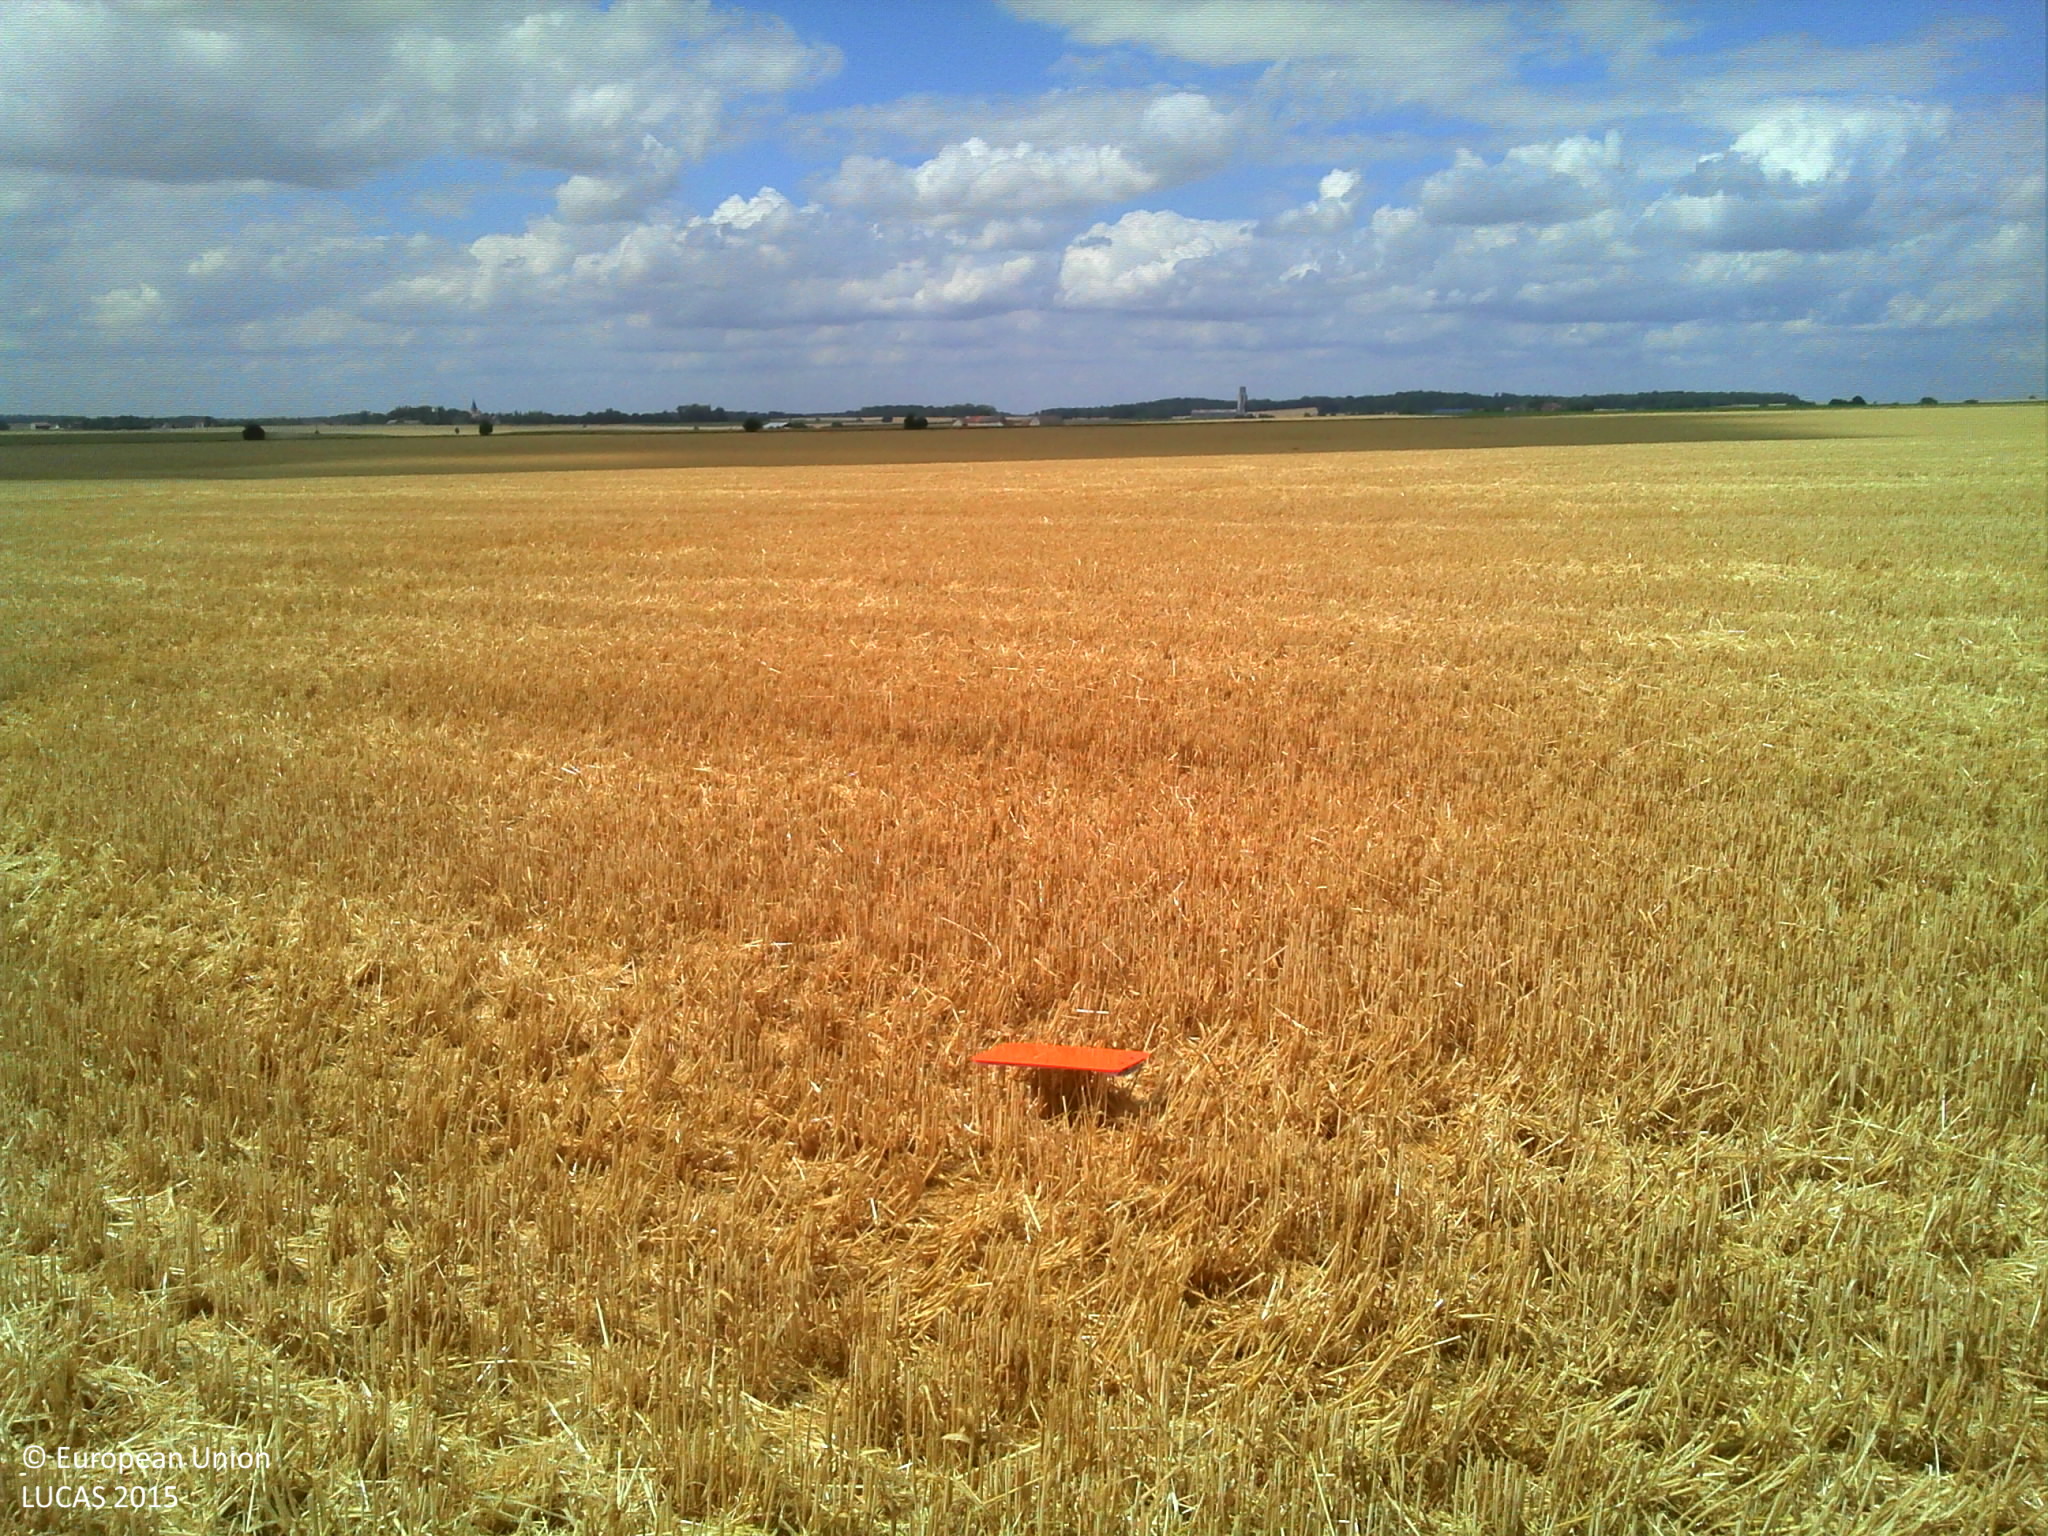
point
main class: Cropland
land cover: Barley
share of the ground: > 75 %
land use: Agriculture (excluding fallow land and kitchen gardens)
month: August
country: FR
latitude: 48.6059
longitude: 3.4431
